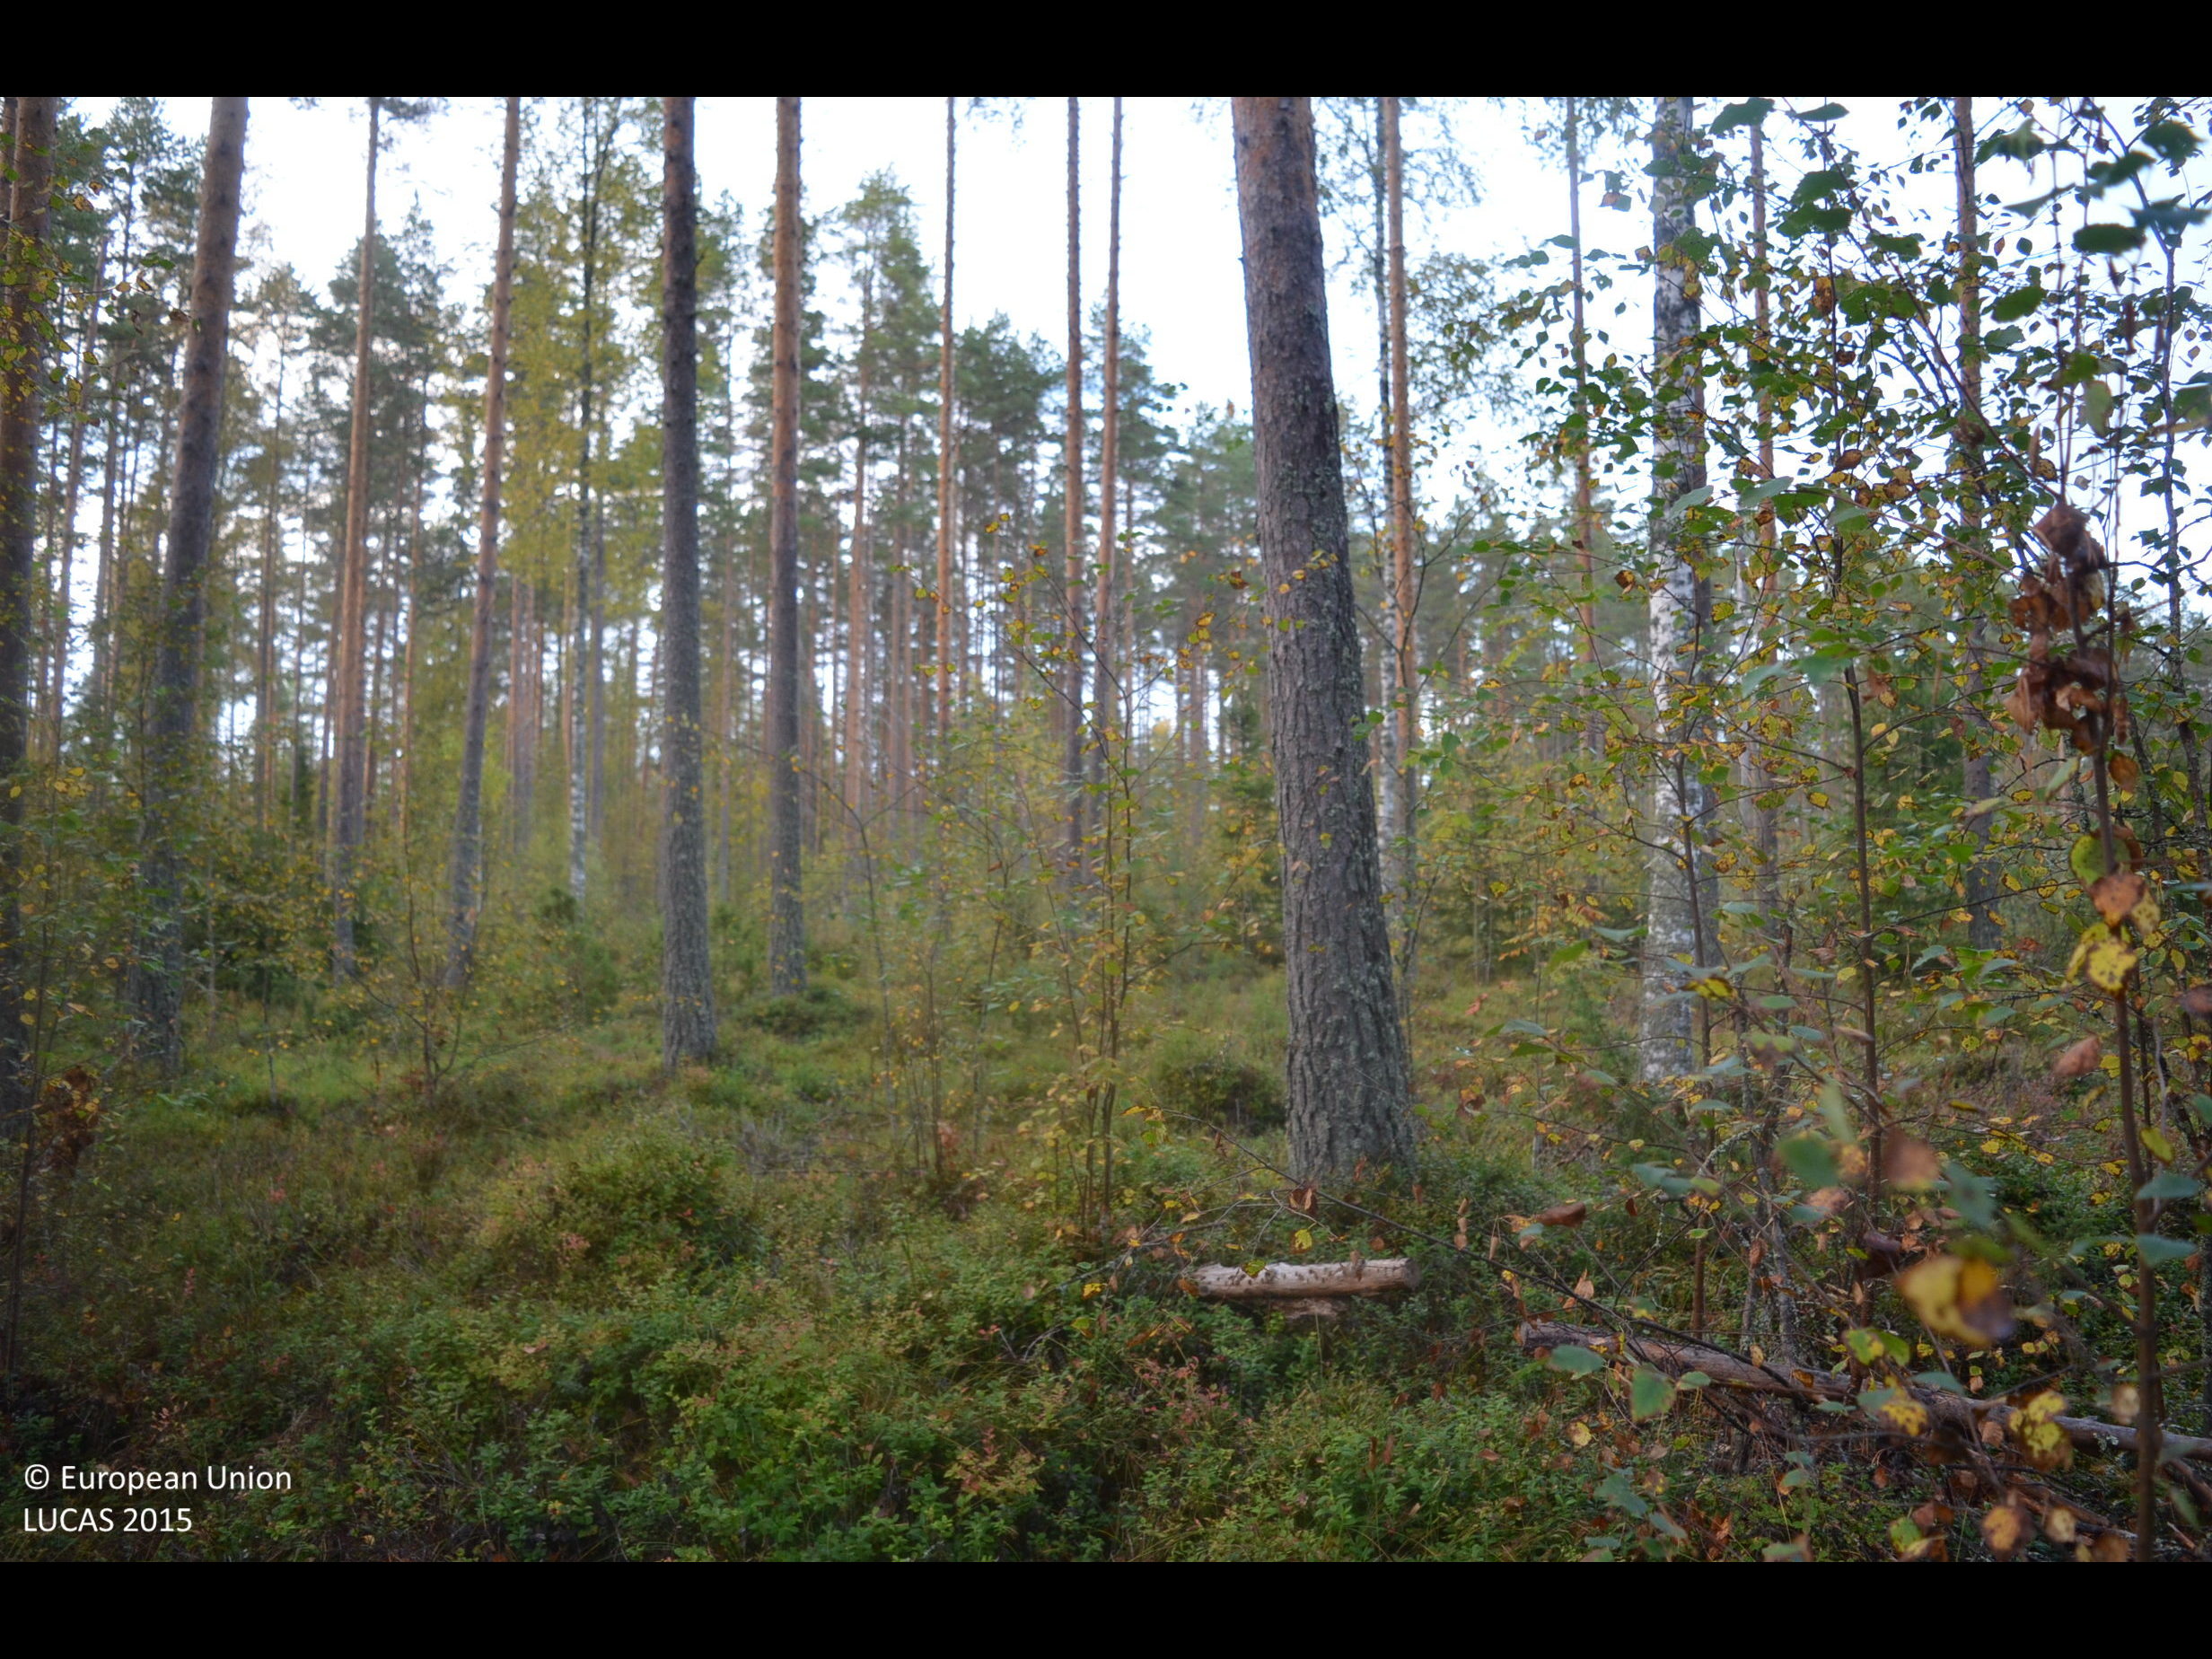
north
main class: Woodland
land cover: Pine dominated mixed woodland
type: boreal forest
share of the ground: 50 - 75 %
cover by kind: coniferous forest trees 40 %, shrubs 35 %, broadleaved forest trees 25 %
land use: Forestry
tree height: > 5 m
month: September
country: FI
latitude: 62.9665
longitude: 23.7778
